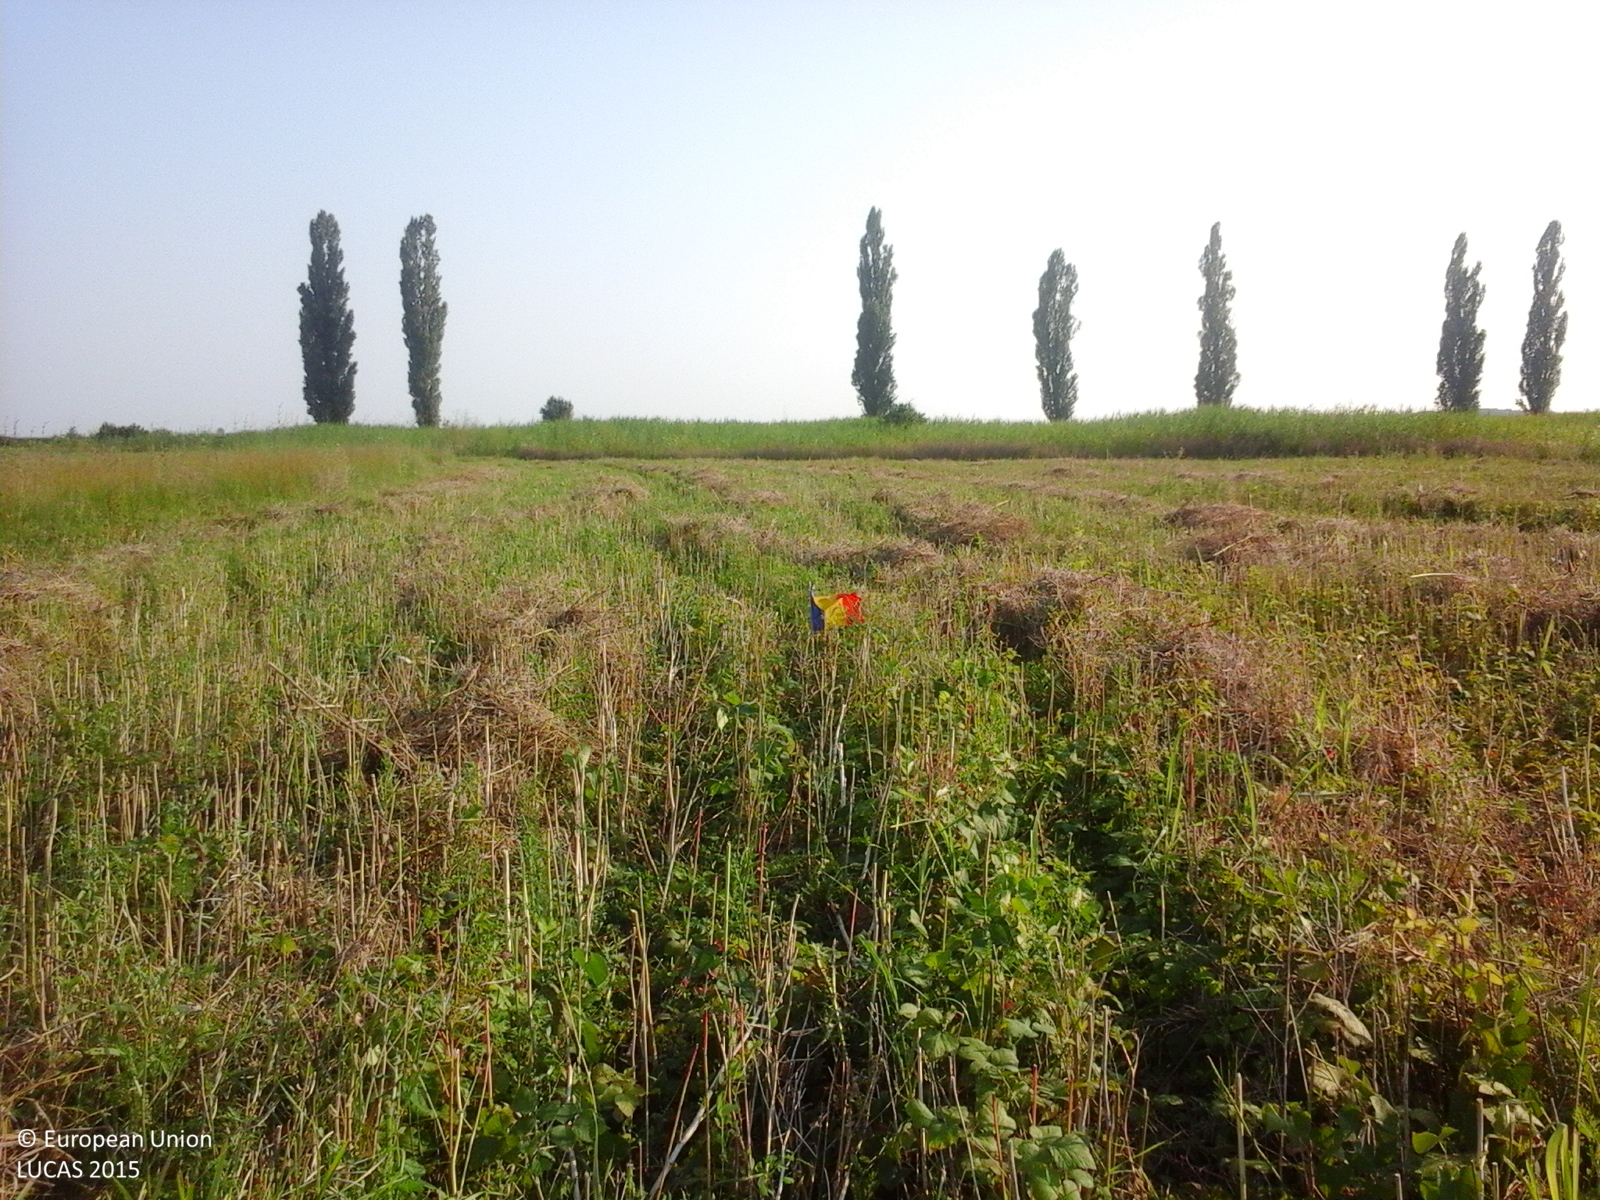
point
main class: Cropland
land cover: Rape and turnip rape
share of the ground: 50 - 75 %
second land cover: Spontaneously vegetated surfaces
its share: 25 - 50 %
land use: Agriculture (excluding fallow land and kitchen gardens)
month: July
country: RO
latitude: 44.6552
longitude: 25.6711
